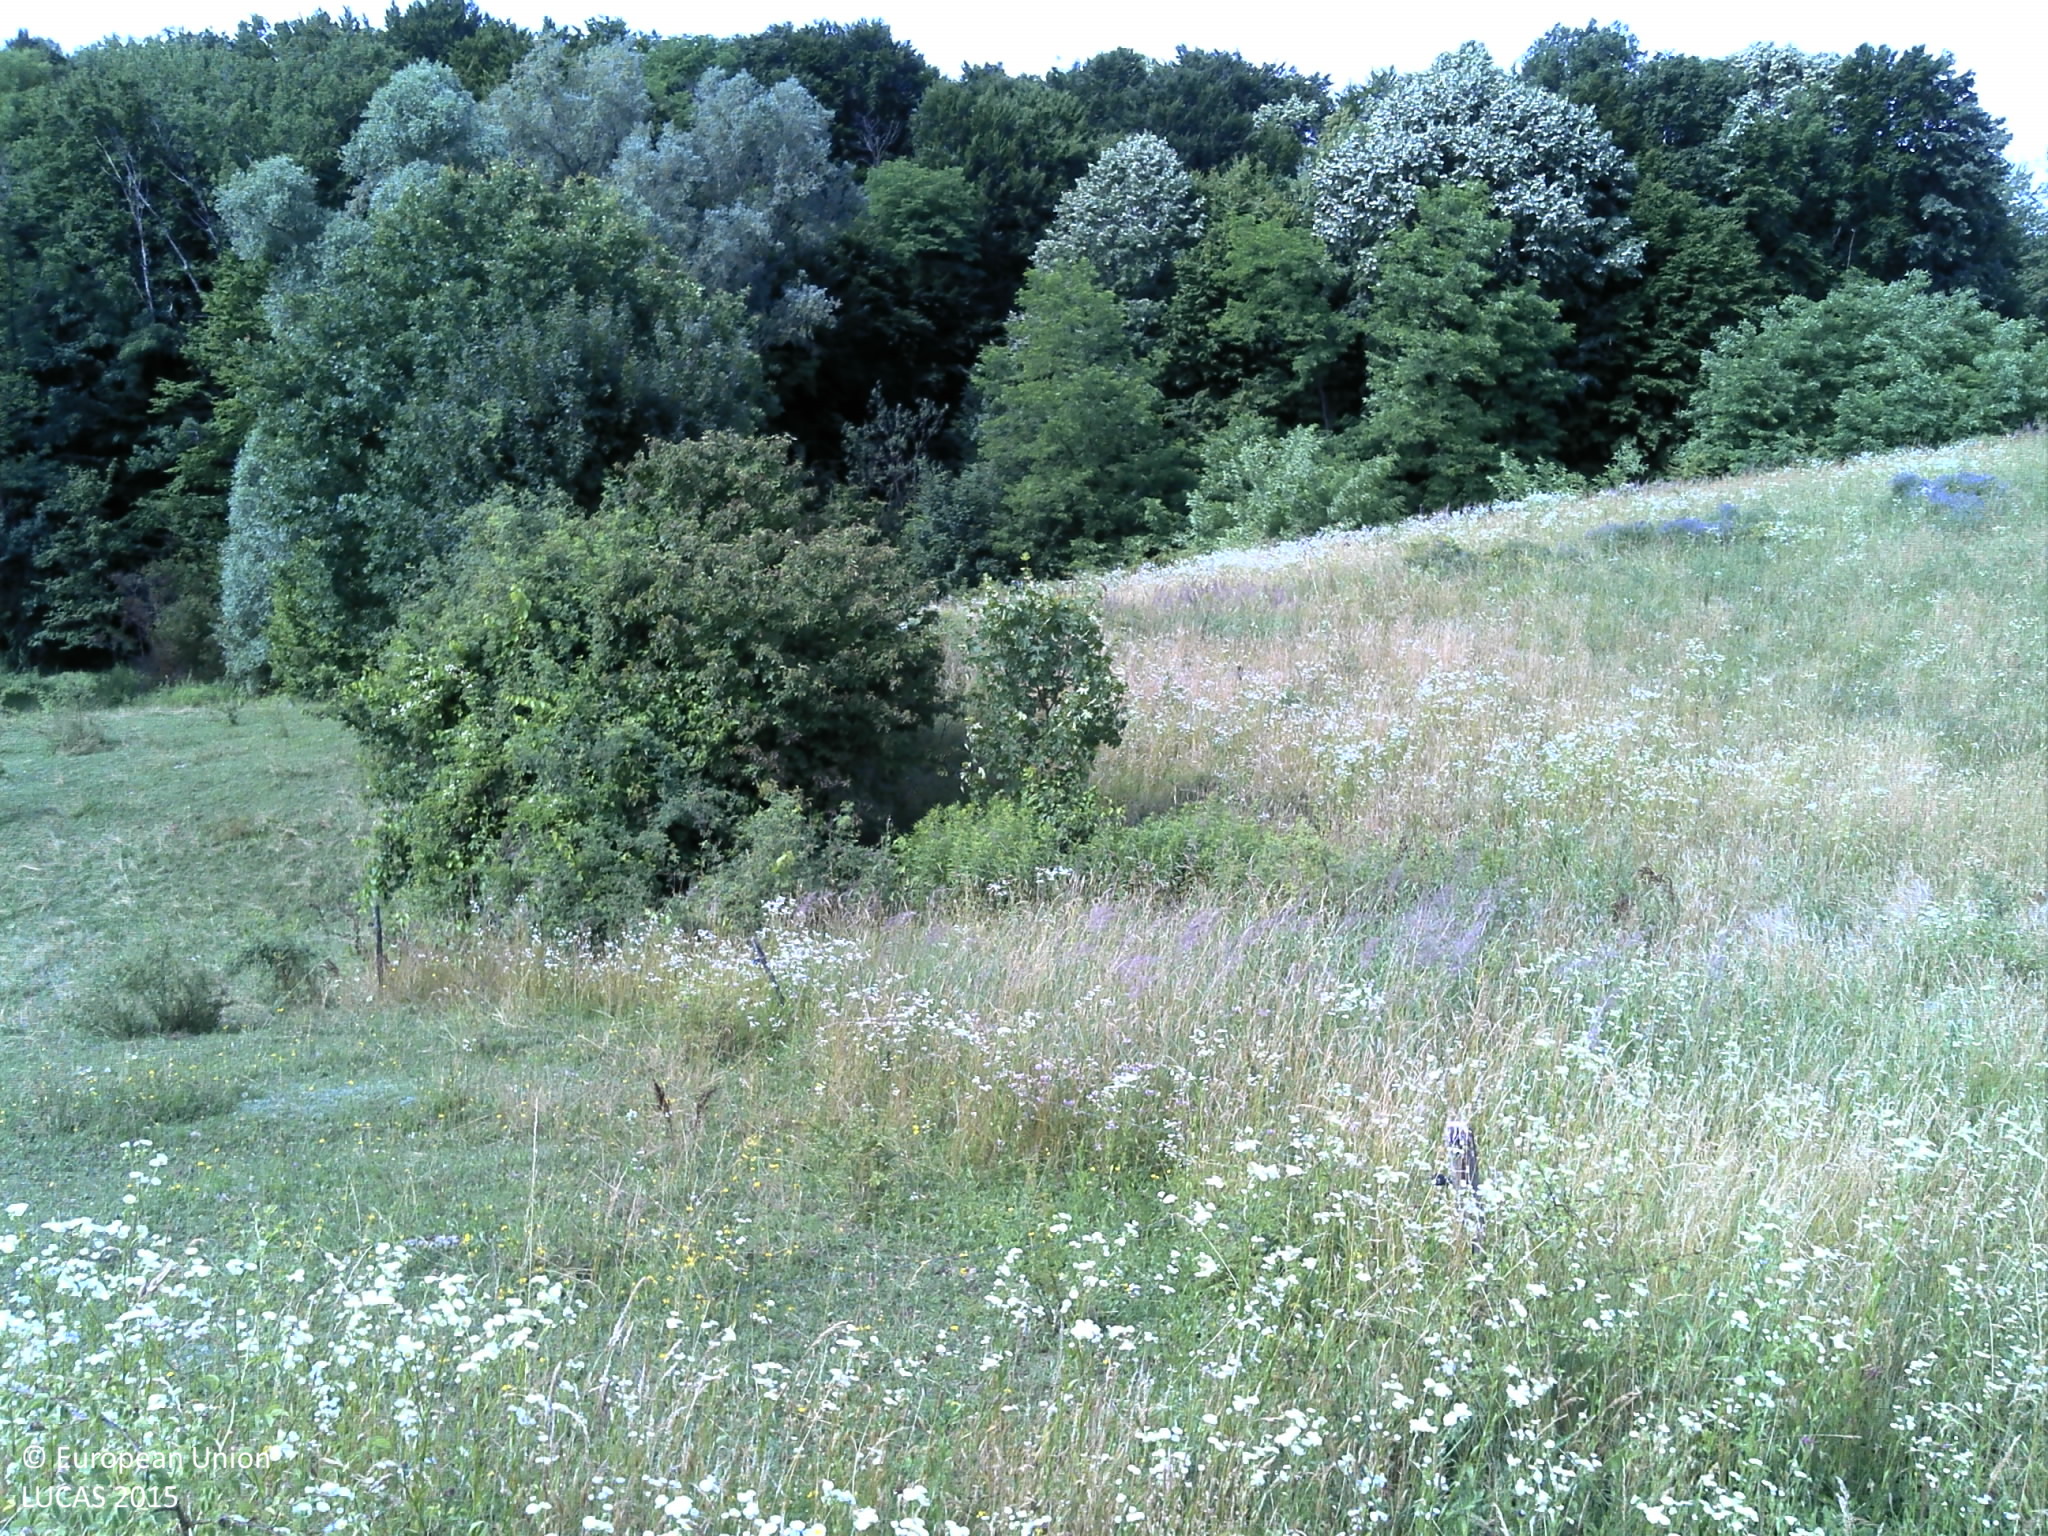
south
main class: Grassland
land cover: Spontaneously vegetated surfaces
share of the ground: > 75 %
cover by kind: herbaceous plants 100 %
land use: Fallow land
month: June
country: HR
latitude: 45.7067
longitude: 17.5165
